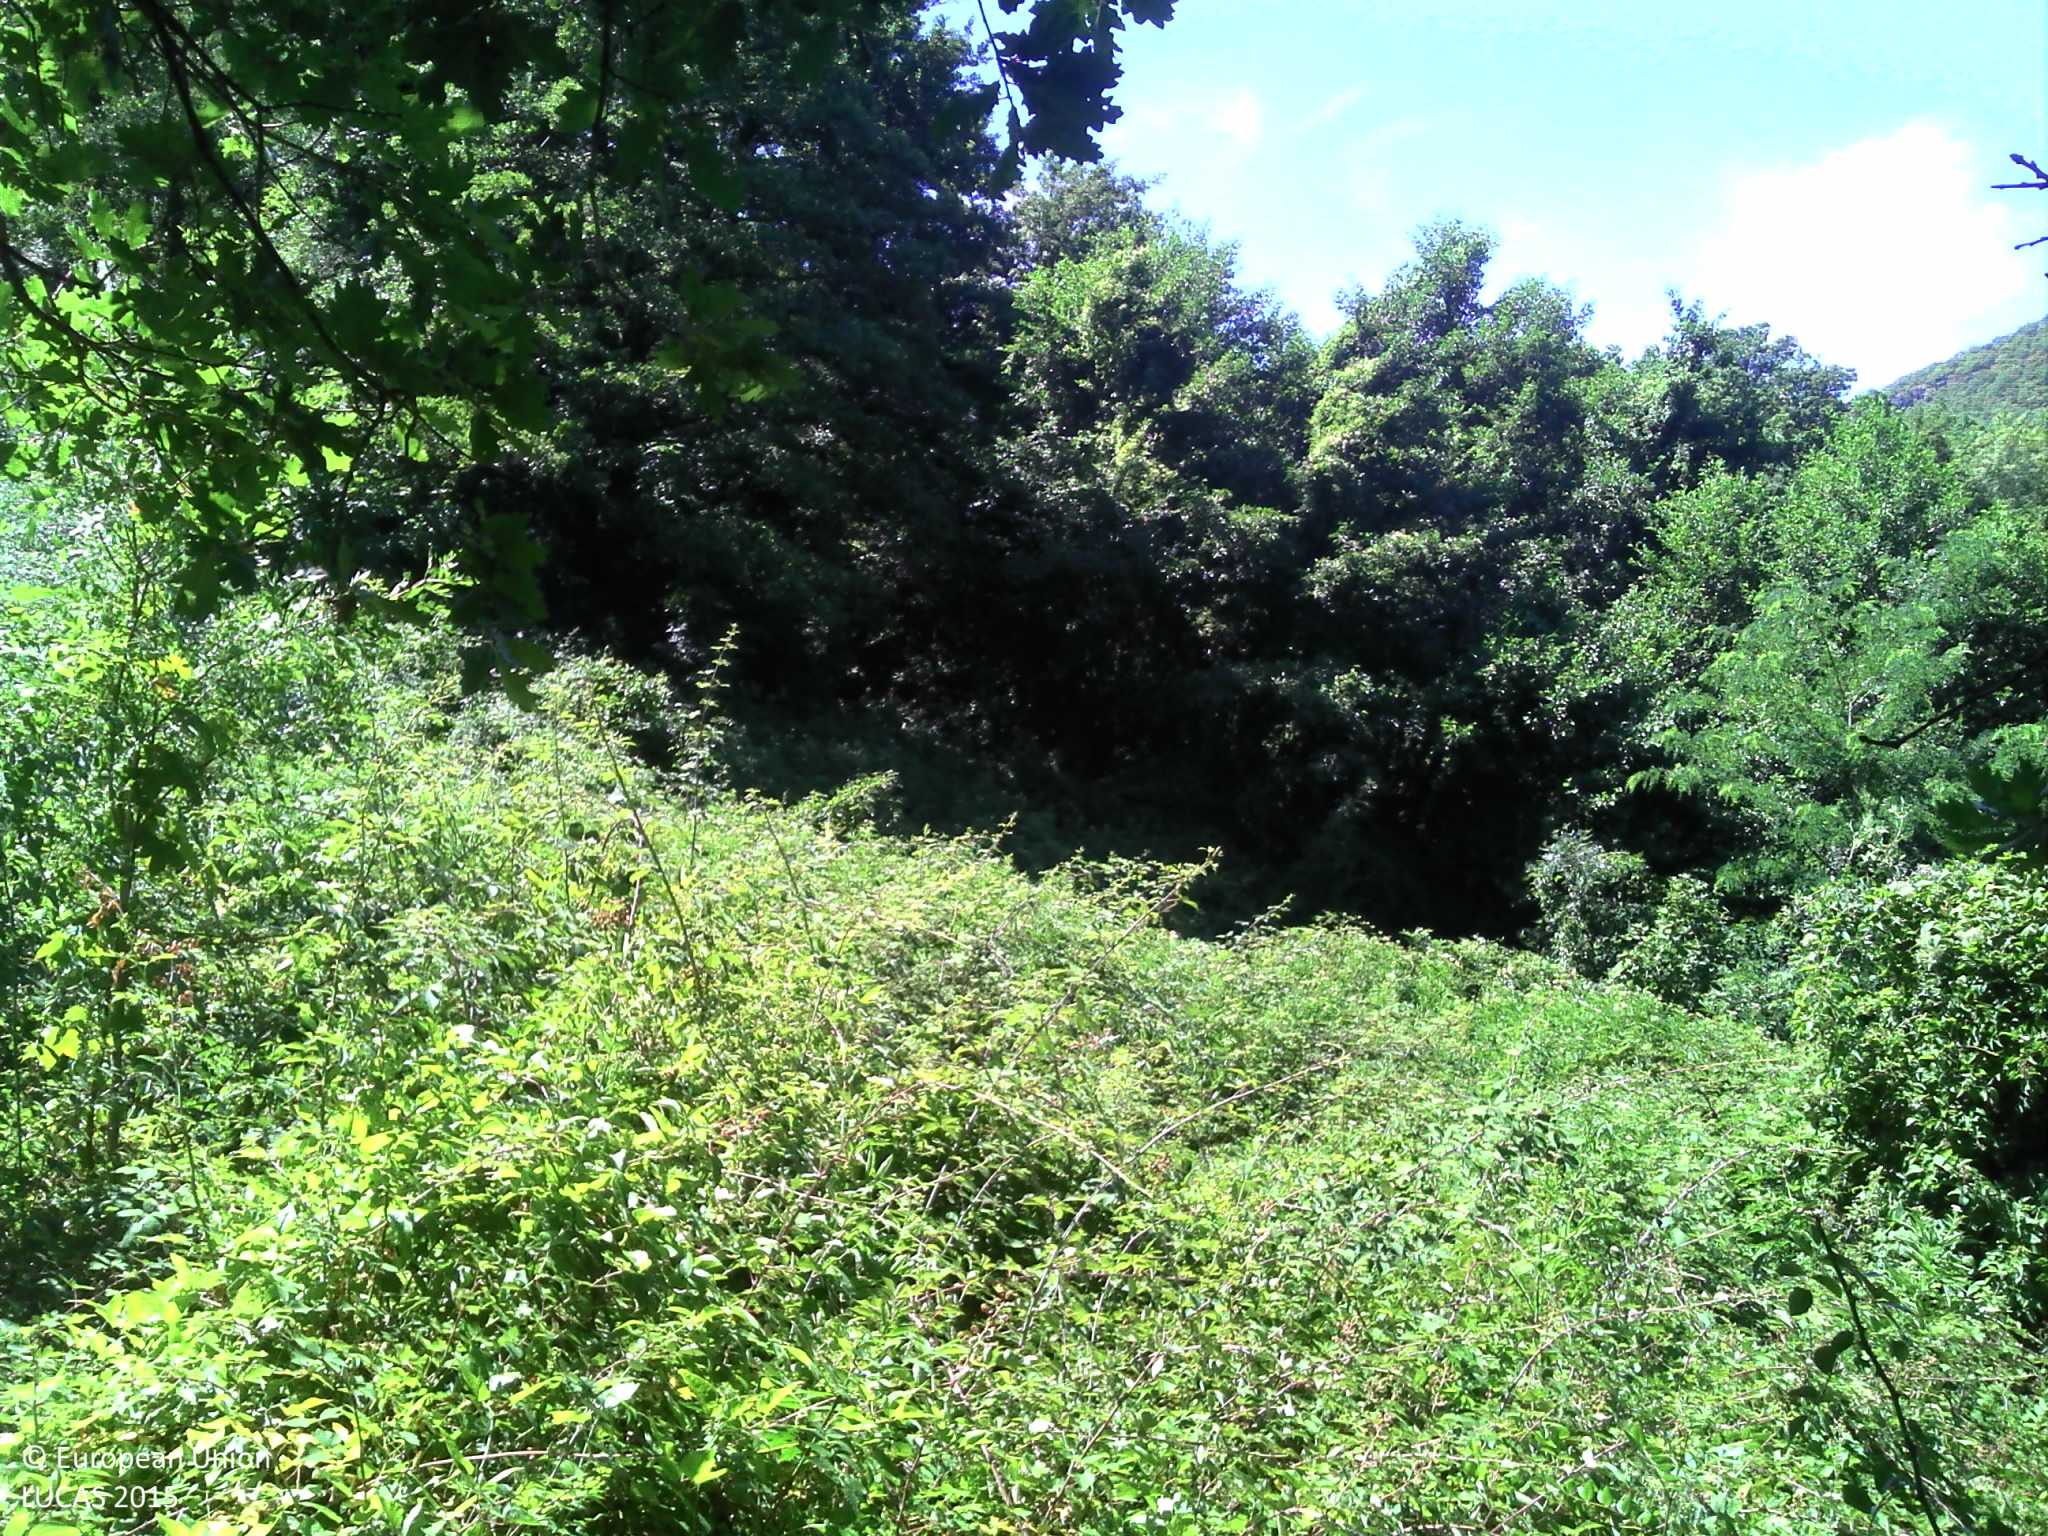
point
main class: Woodland
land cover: Broadleaved woodland
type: broadleaved evergreen forest
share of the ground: > 75 %
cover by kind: broadleaved forest trees 90 %, herbaceous plants 10 %
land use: Semi-natural and natural areas not in use
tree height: > 5 m
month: July
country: FR
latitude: 44.6988
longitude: 4.6175
